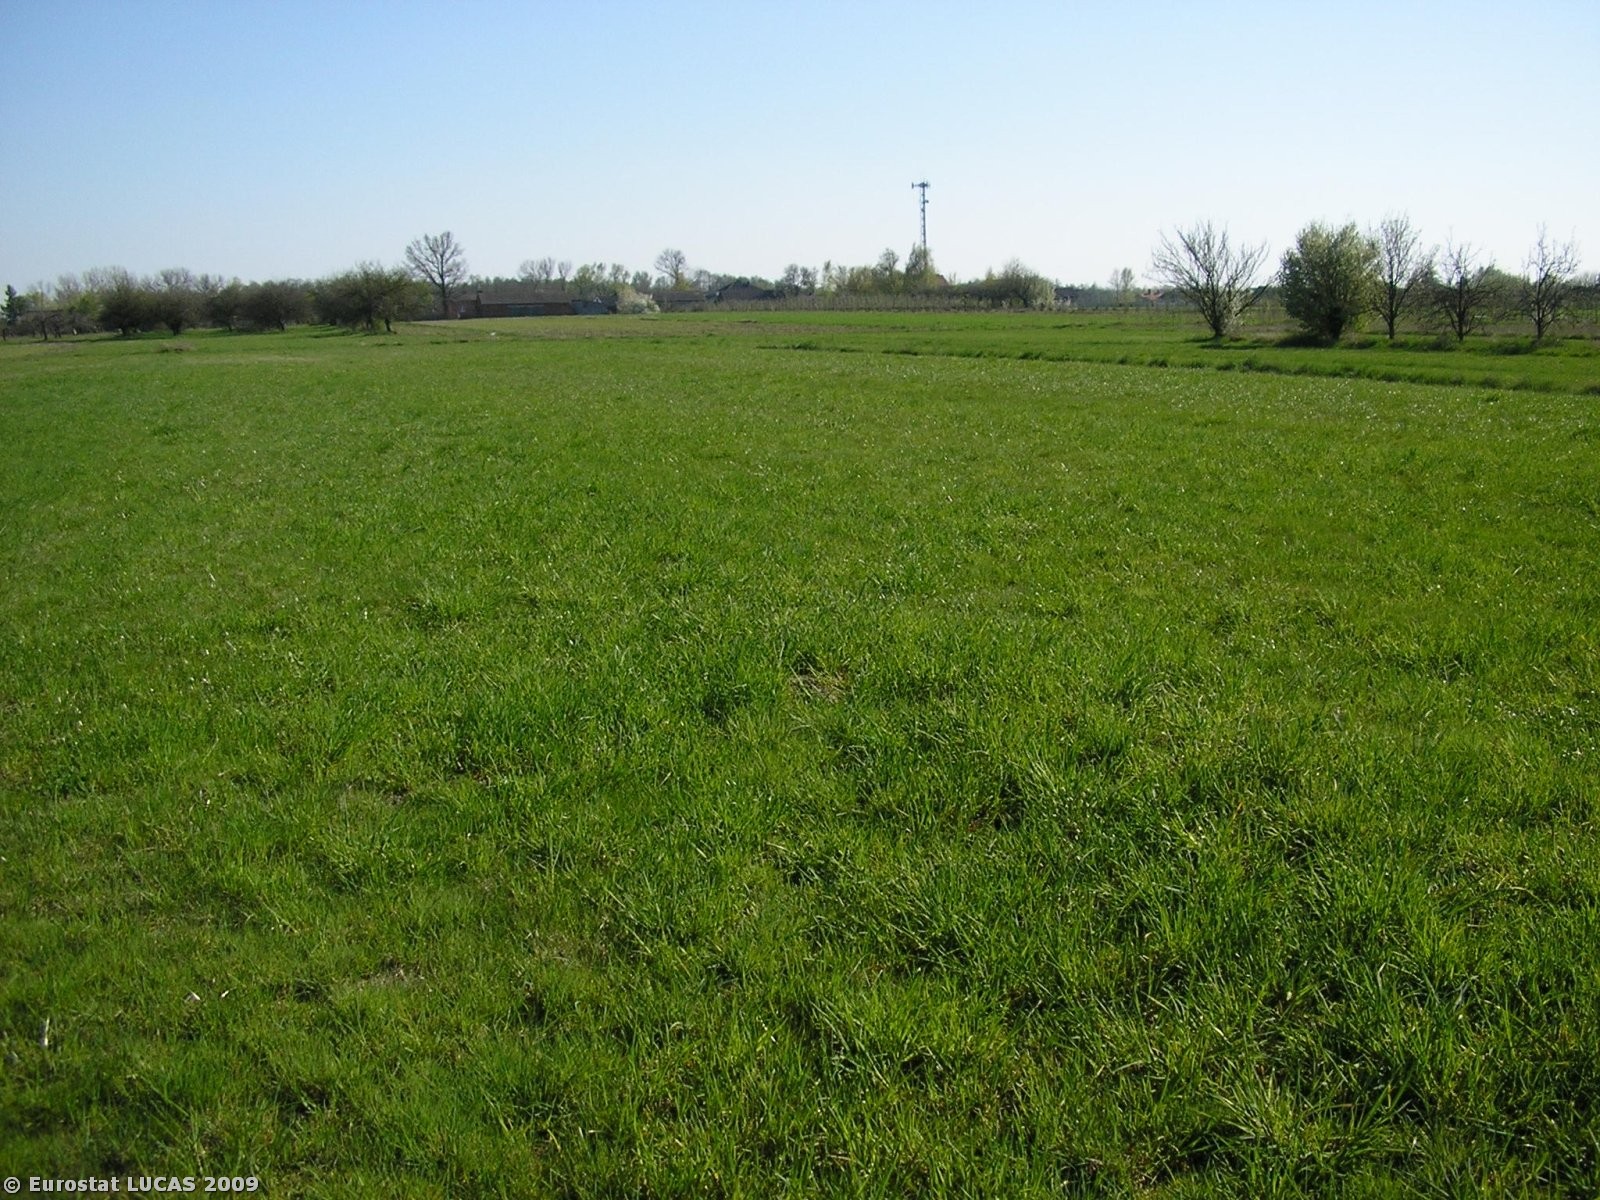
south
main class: Grassland
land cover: Grassland without tree/shrub cover
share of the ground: > 75 %
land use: Agriculture (excluding fallow land and kitchen gardens)
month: April
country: PL
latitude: 52.1448
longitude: 20.1022
